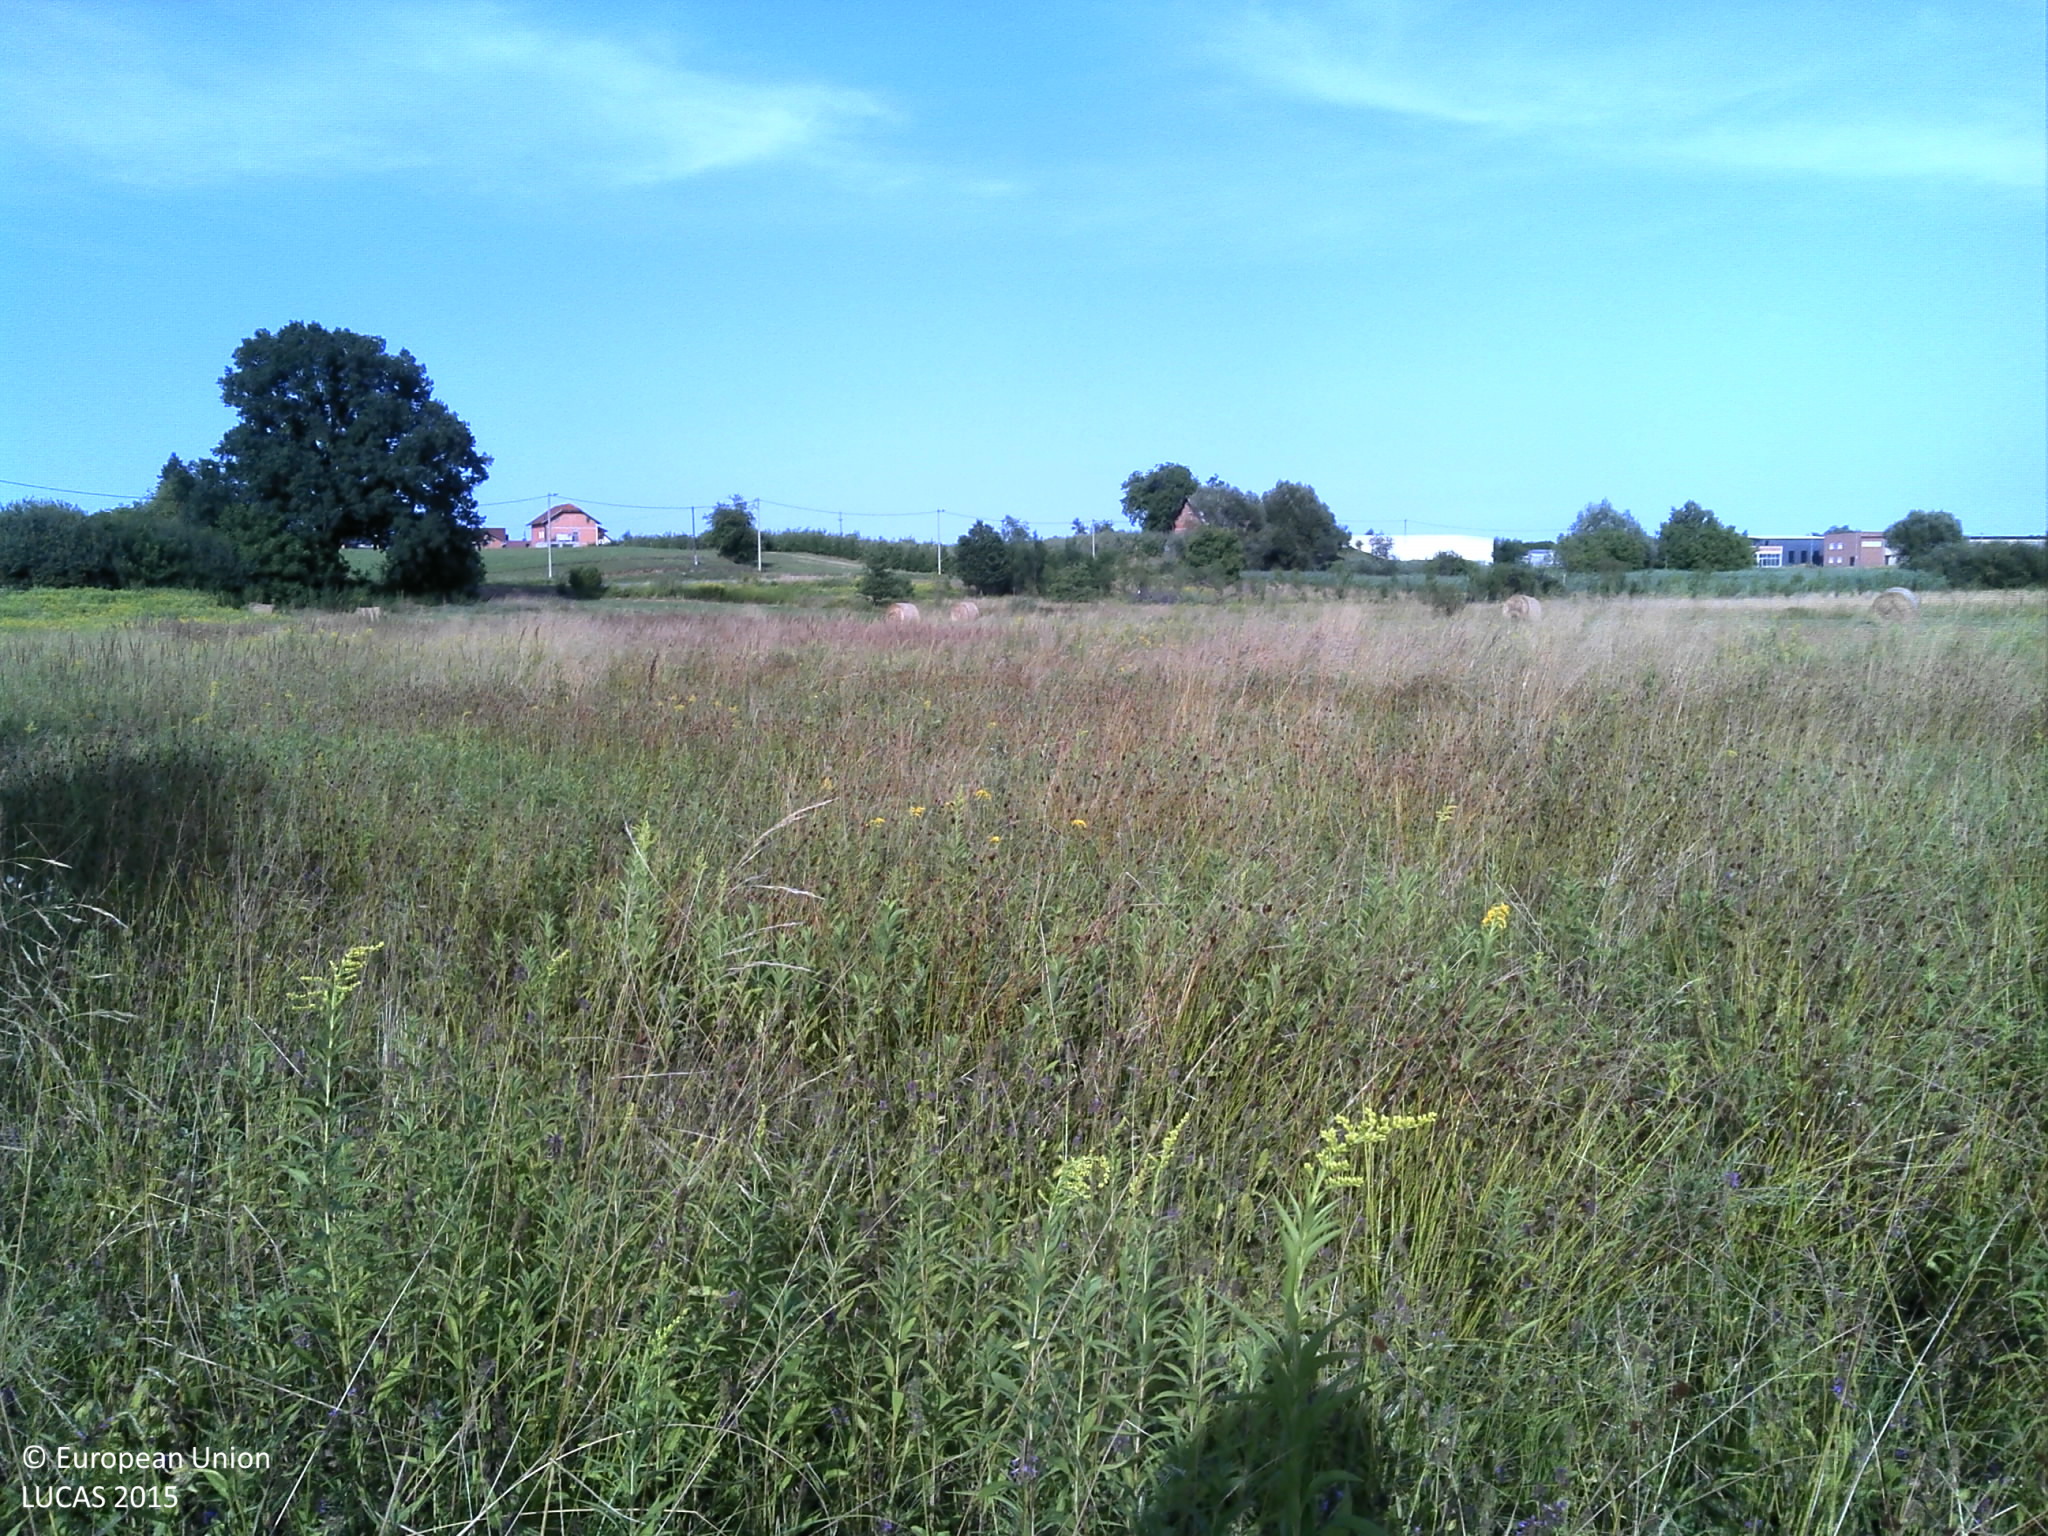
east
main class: Grassland
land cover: Grassland without tree/shrub cover
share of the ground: > 75 %
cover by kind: herbaceous plants 100 %
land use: Agriculture (excluding fallow land and kitchen gardens)
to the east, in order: Grassland without tree/shrub cover; Lines of trees; Grassland without tree/shrub cover; Shrubland without tree cover
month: July
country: HR
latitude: 45.6066
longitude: 16.5764
